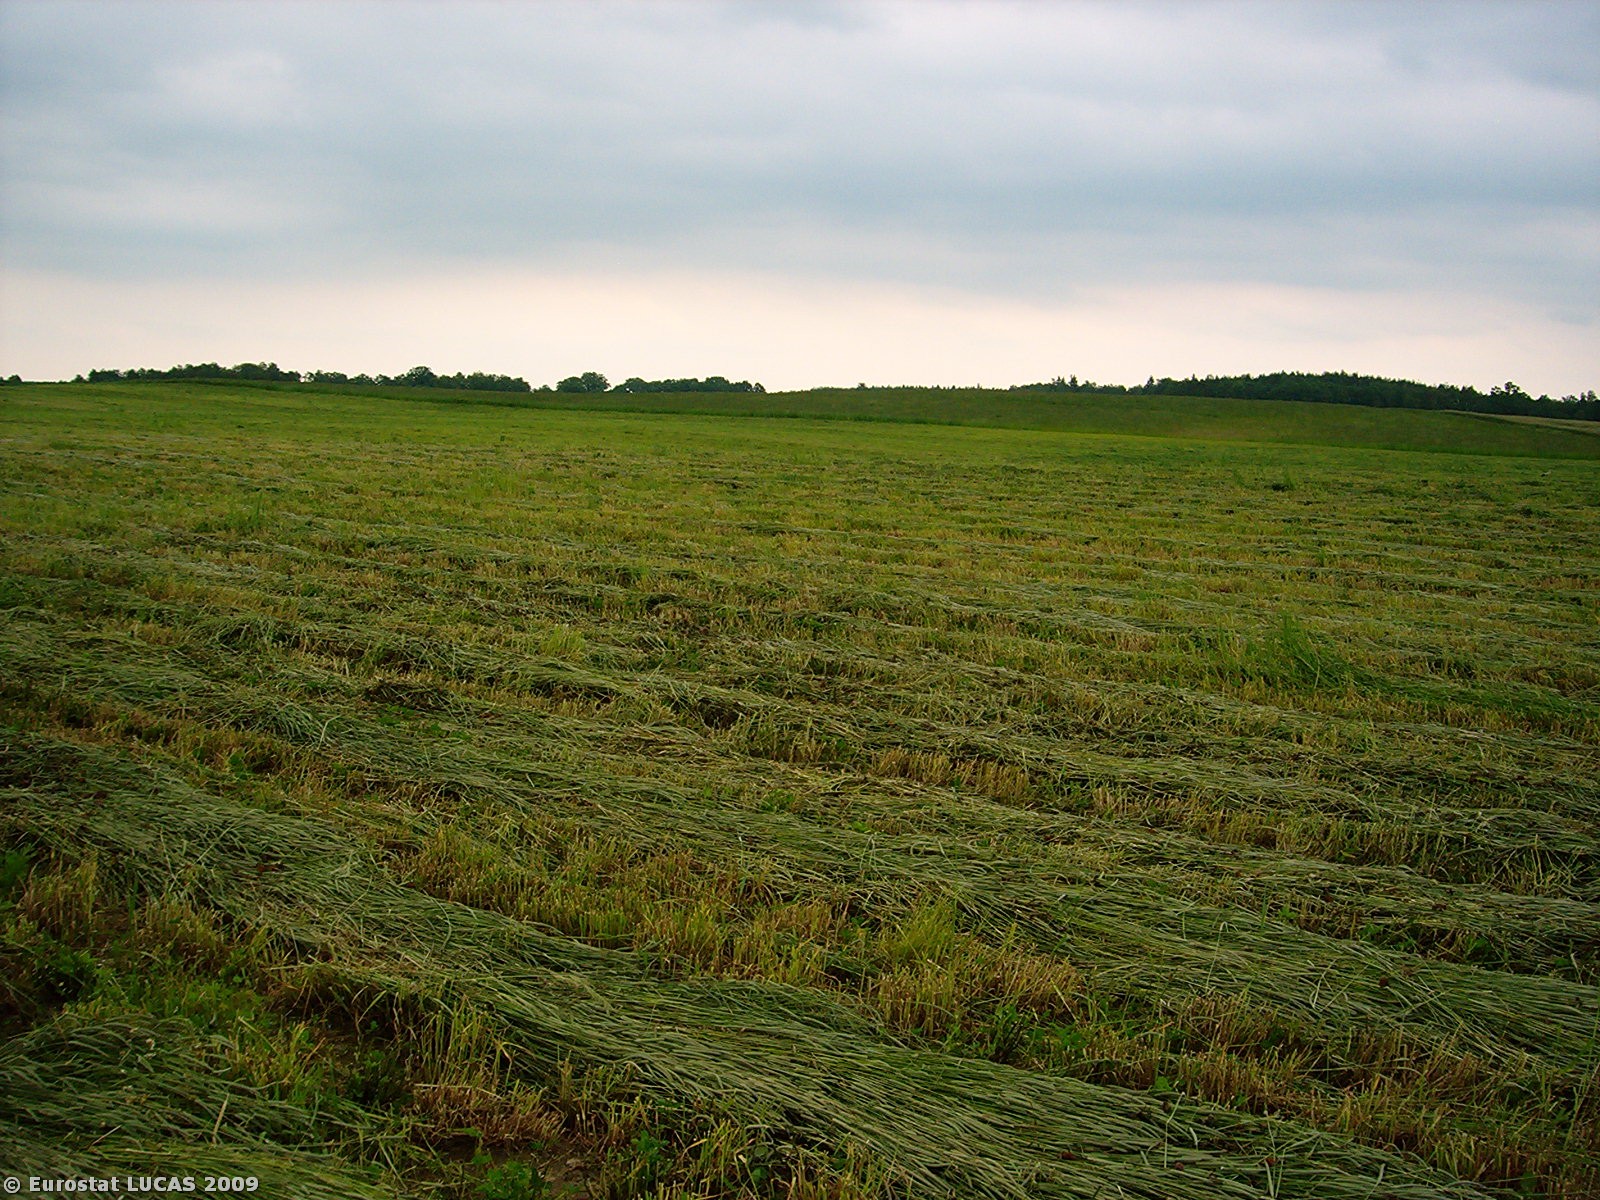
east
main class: Cropland
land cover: Clovers
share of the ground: > 75 %
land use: Agriculture (excluding fallow land and kitchen gardens)
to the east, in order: Clovers
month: June
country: PL
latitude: 53.0631
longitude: 15.4502
